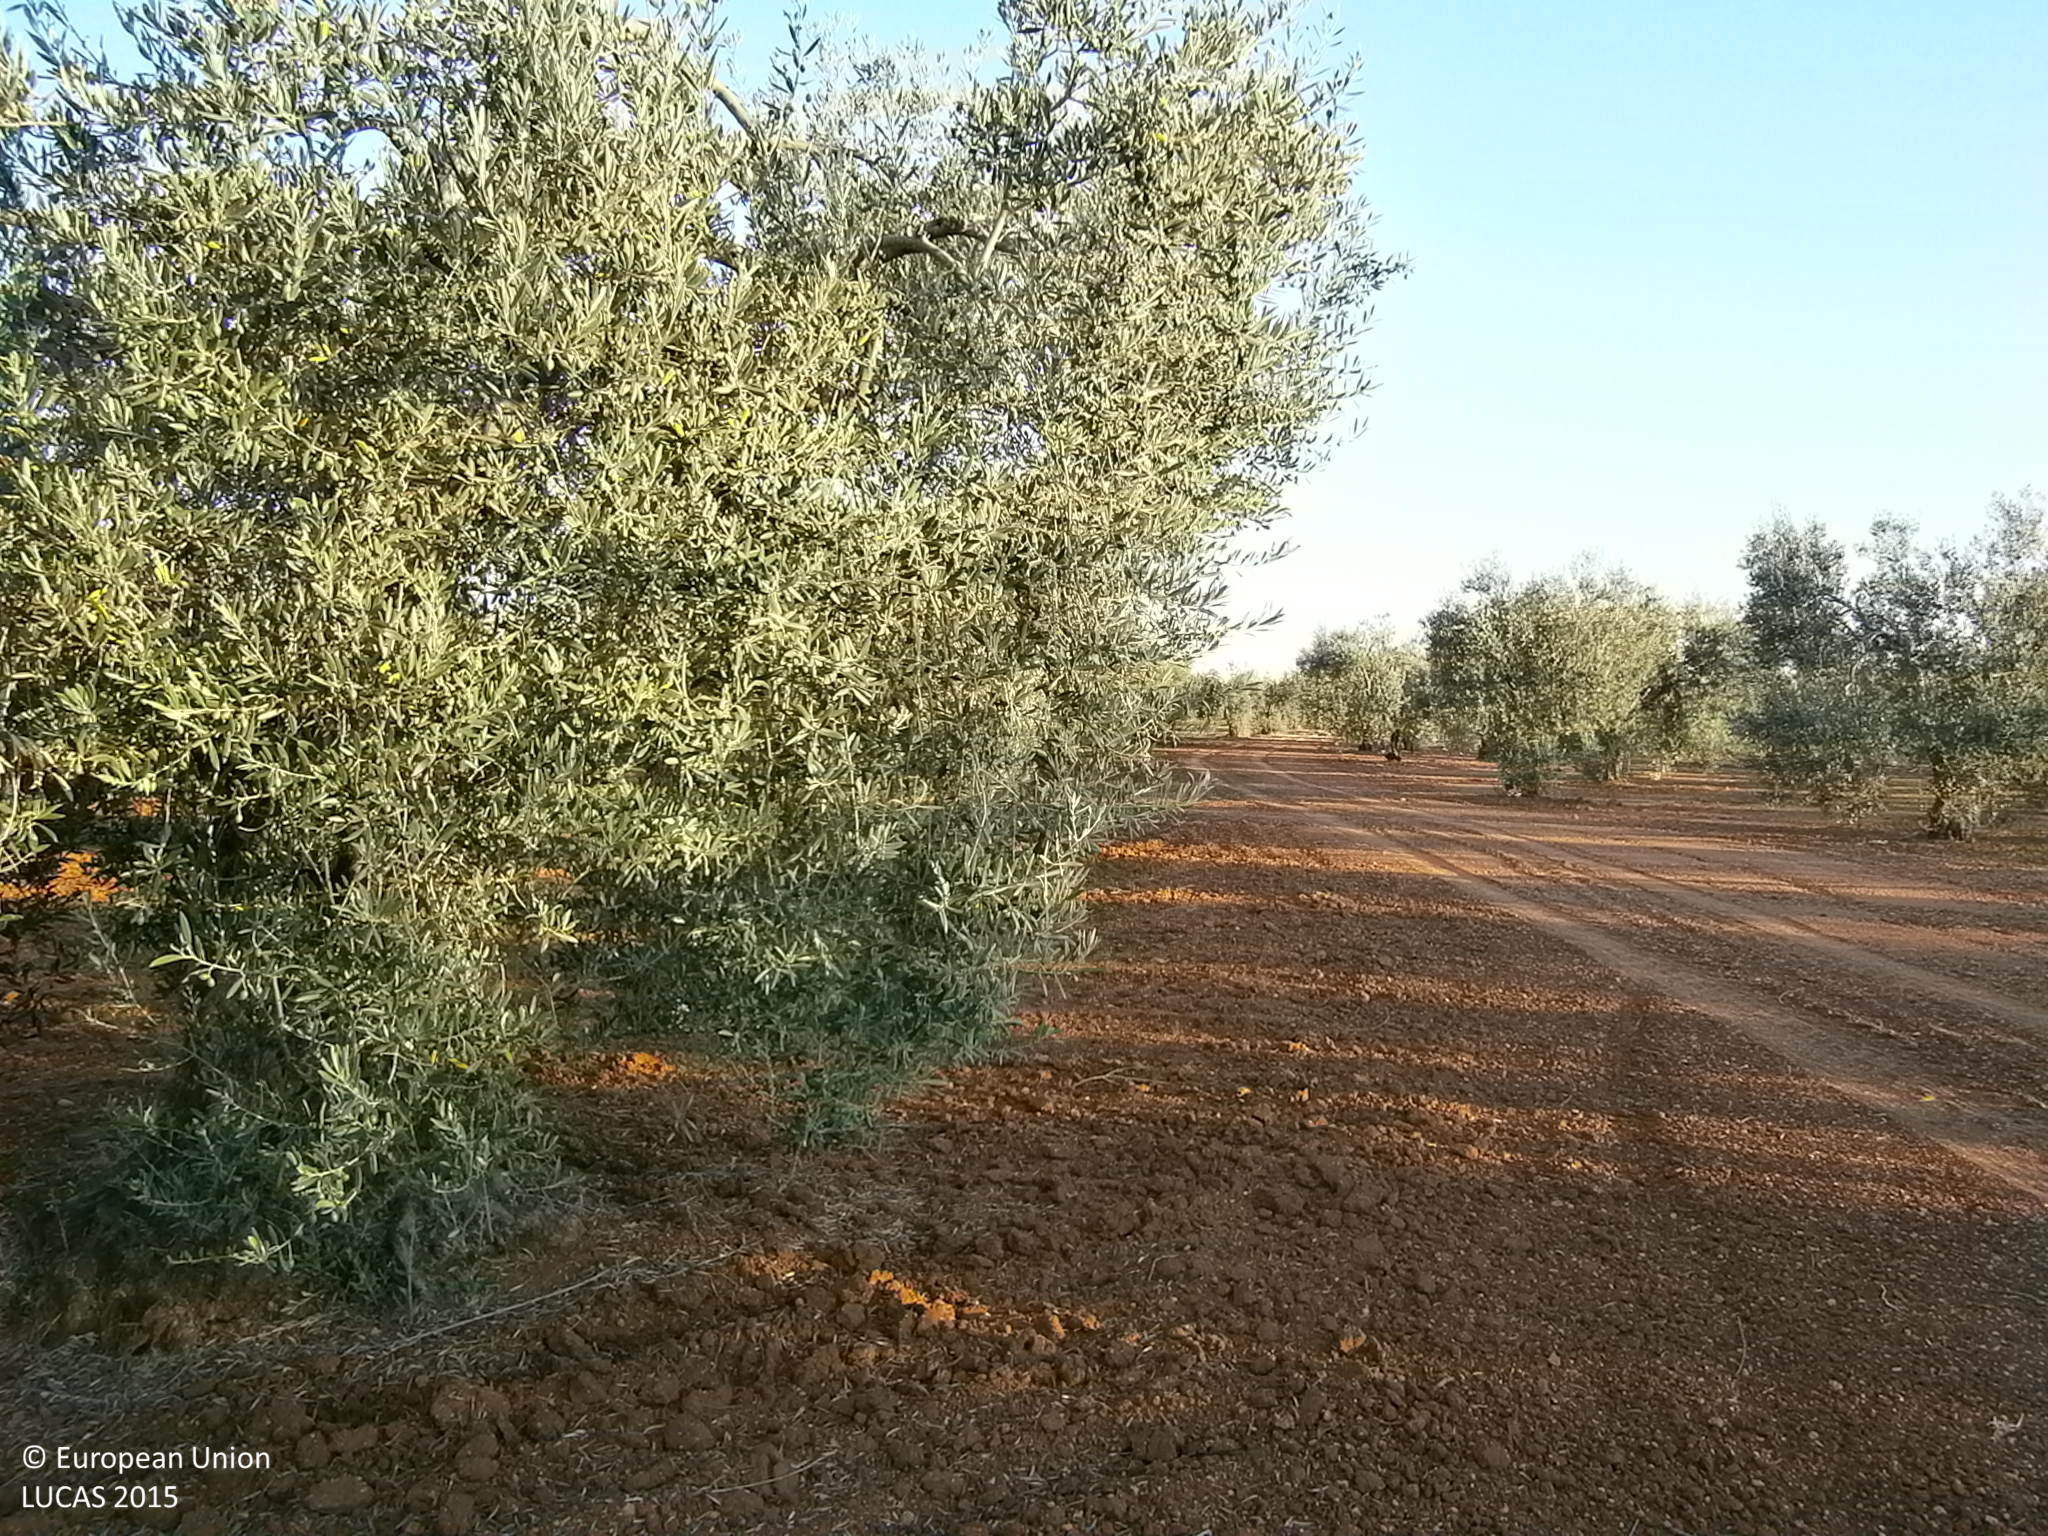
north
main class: Cropland
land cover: Olive groves
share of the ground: 25 - 50 %
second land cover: Other bare soil
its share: > 75 %
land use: Agriculture (excluding fallow land and kitchen gardens)
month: June
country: ES
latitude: 38.6645
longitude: -6.6664
